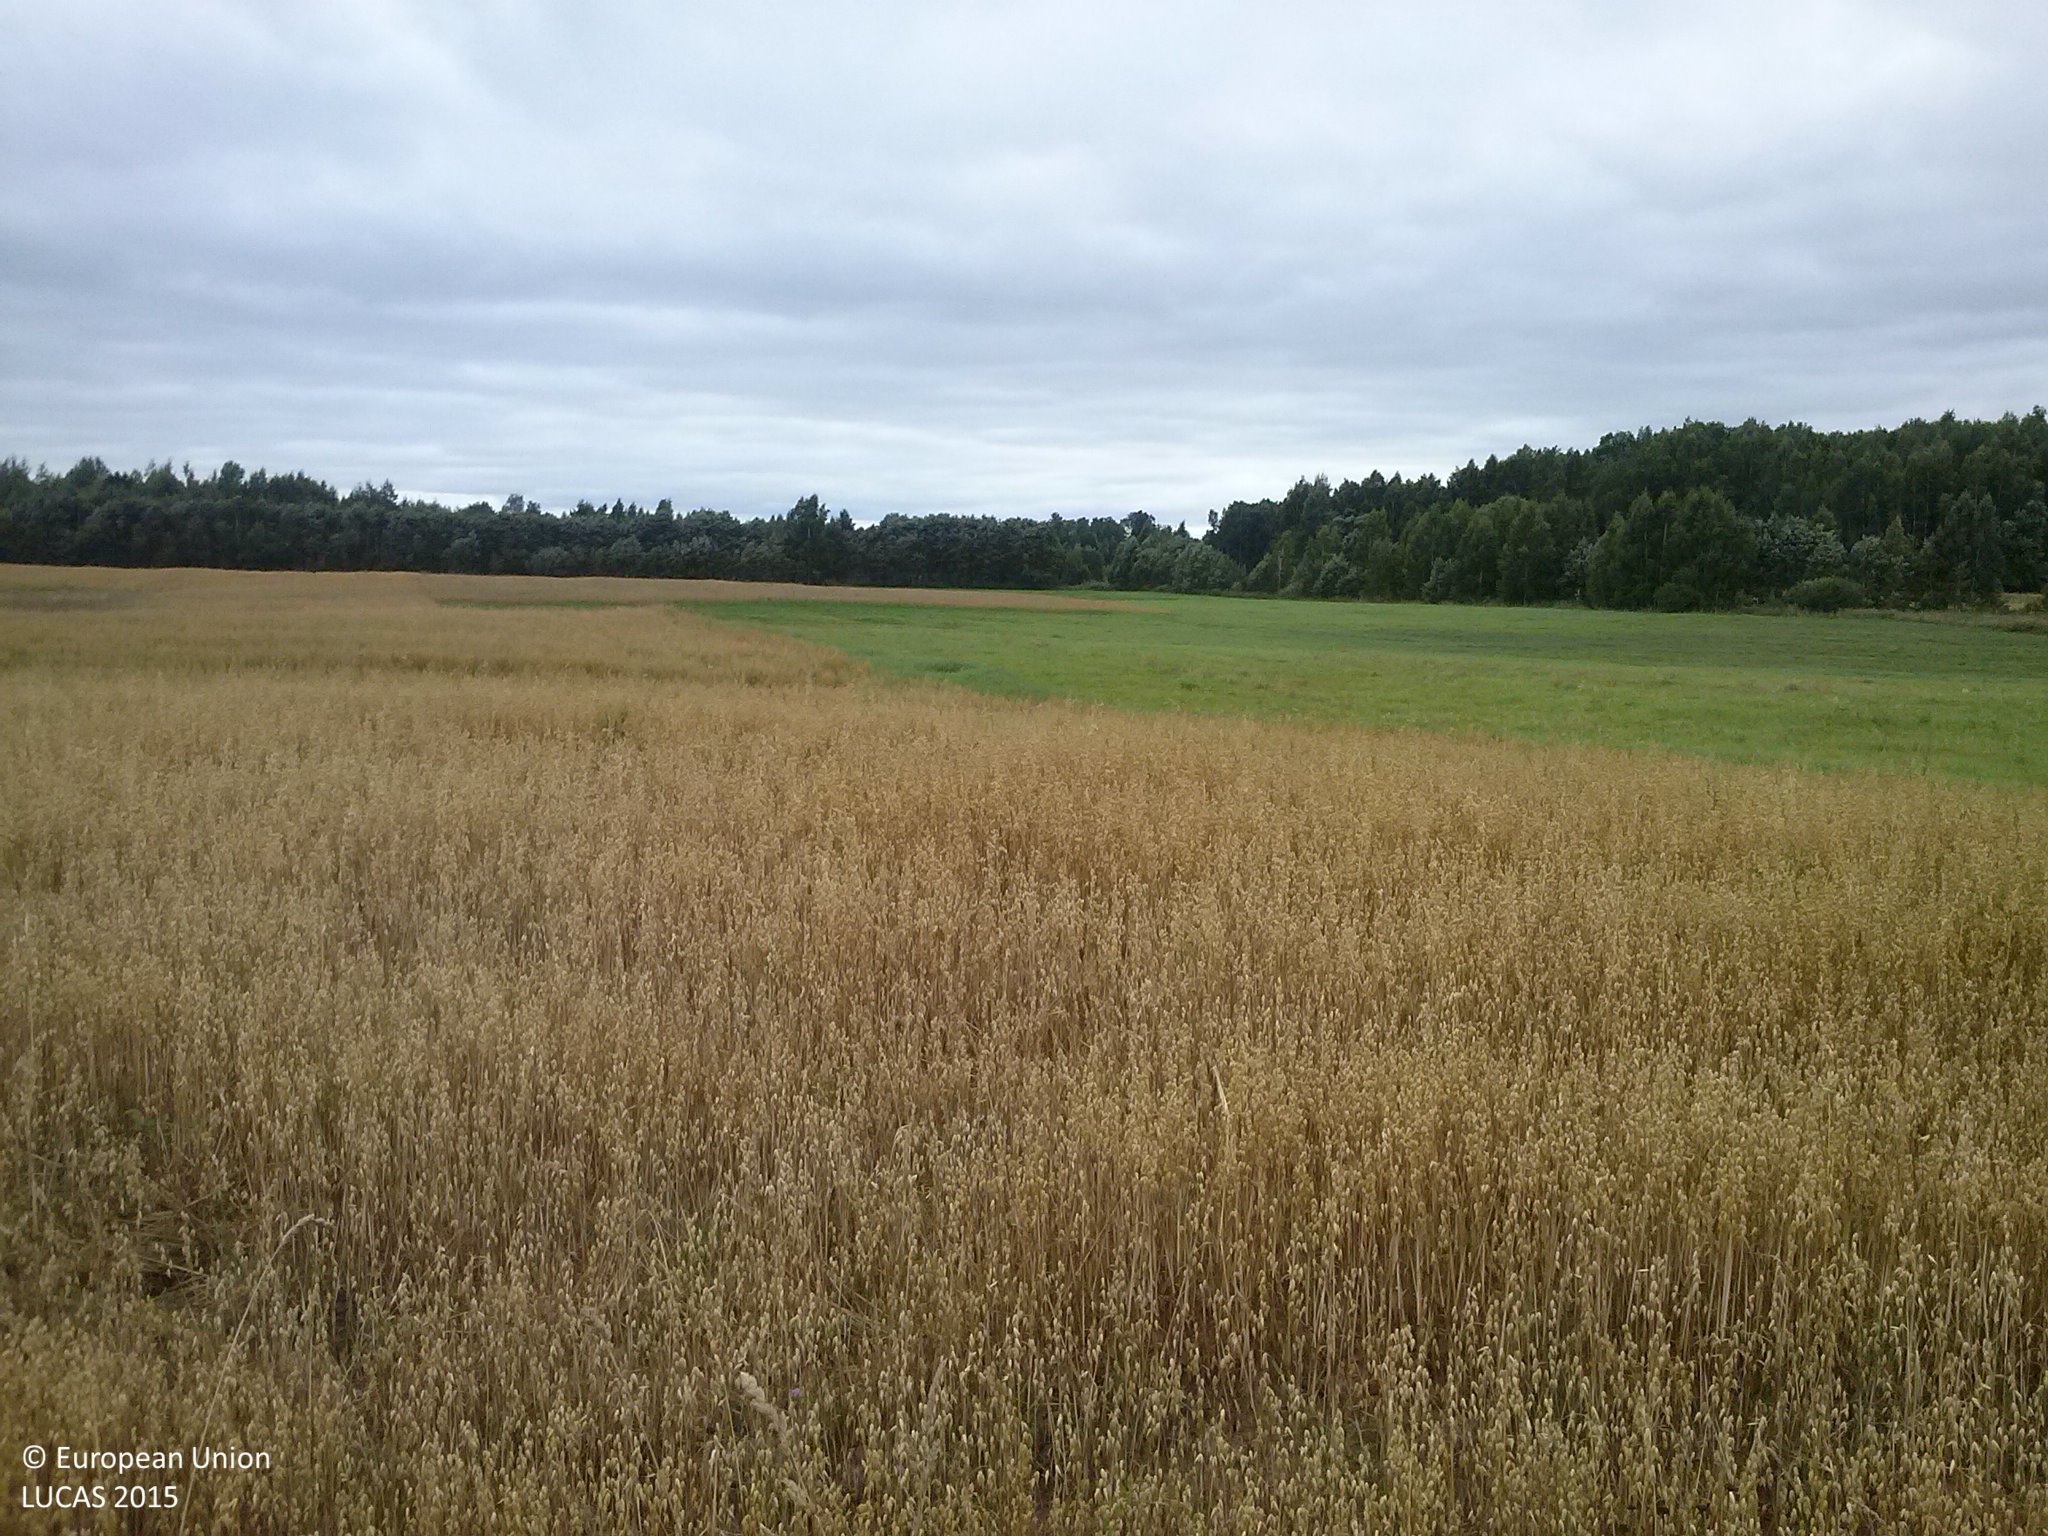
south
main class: Cropland
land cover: Oats
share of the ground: > 75 %
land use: Agriculture (excluding fallow land and kitchen gardens)
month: August
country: LV
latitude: 56.1992
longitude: 26.7417
